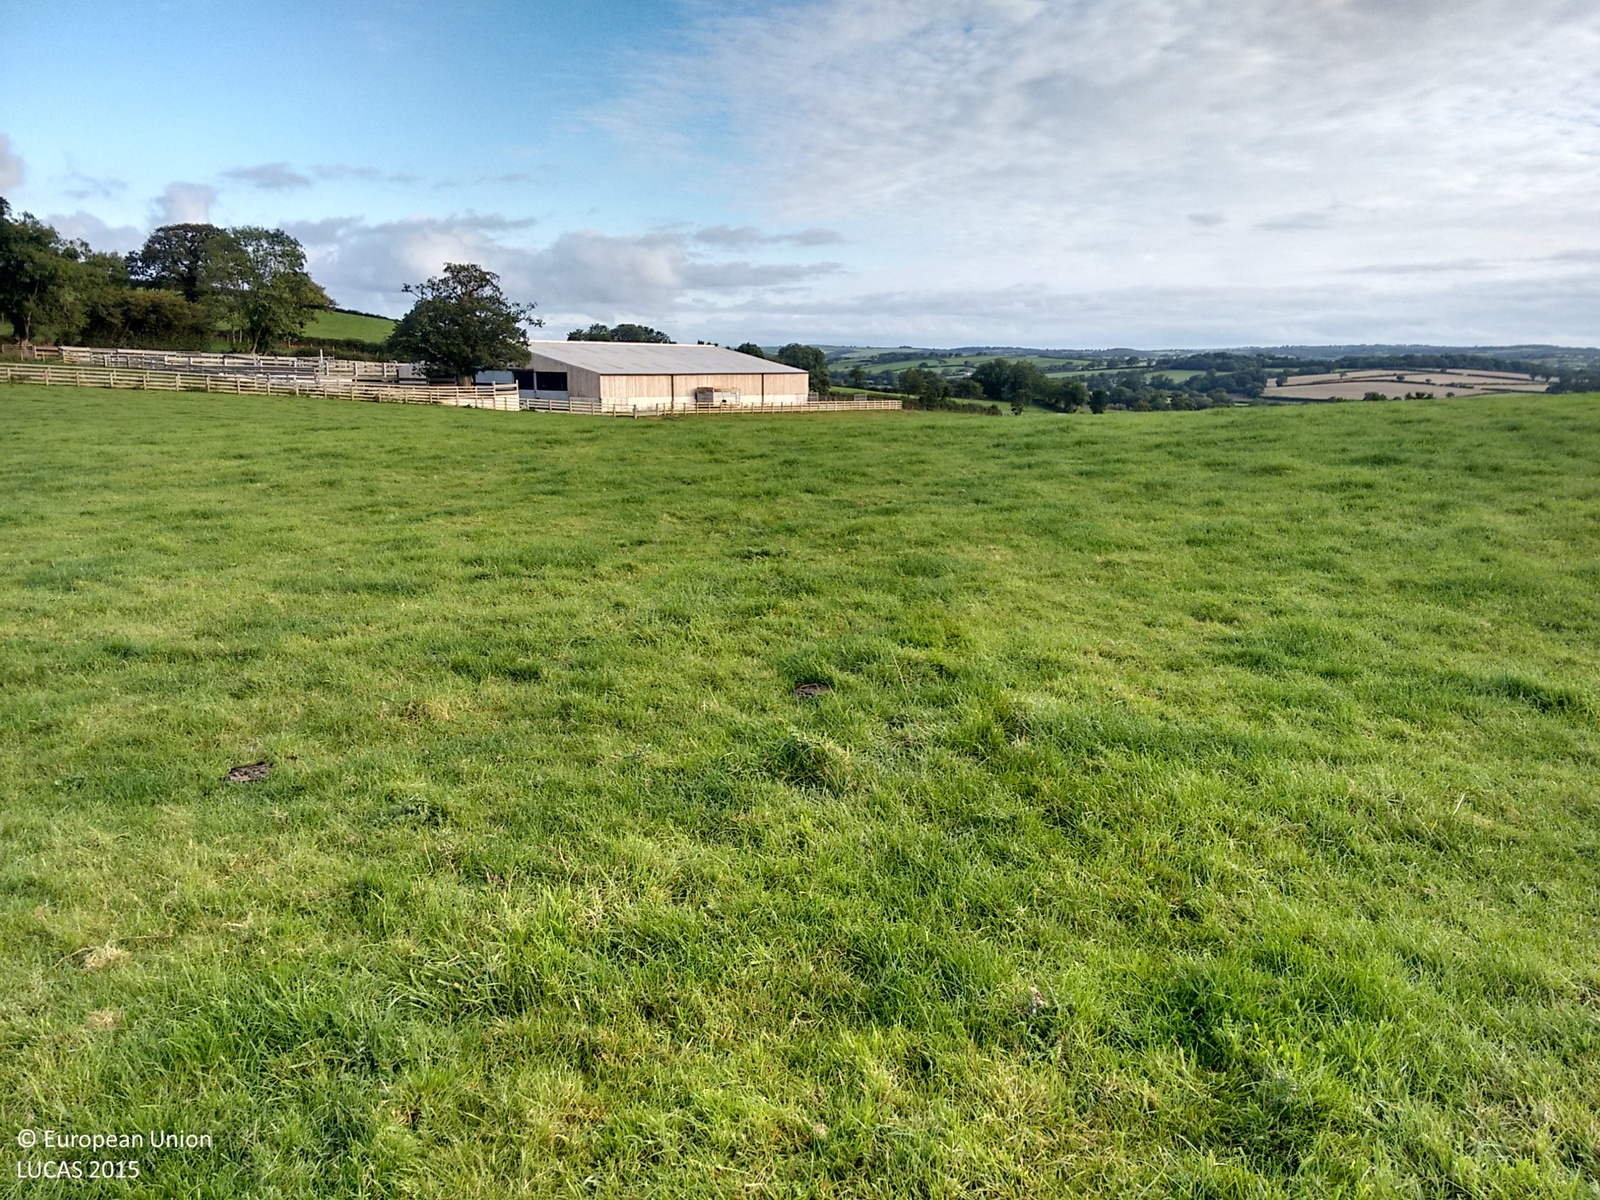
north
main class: Grassland
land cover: Grassland without tree/shrub cover
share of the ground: > 75 %
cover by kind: herbaceous plants 100 %
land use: Agriculture (excluding fallow land and kitchen gardens)
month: September
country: GB
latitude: 50.6417
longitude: -4.3409
